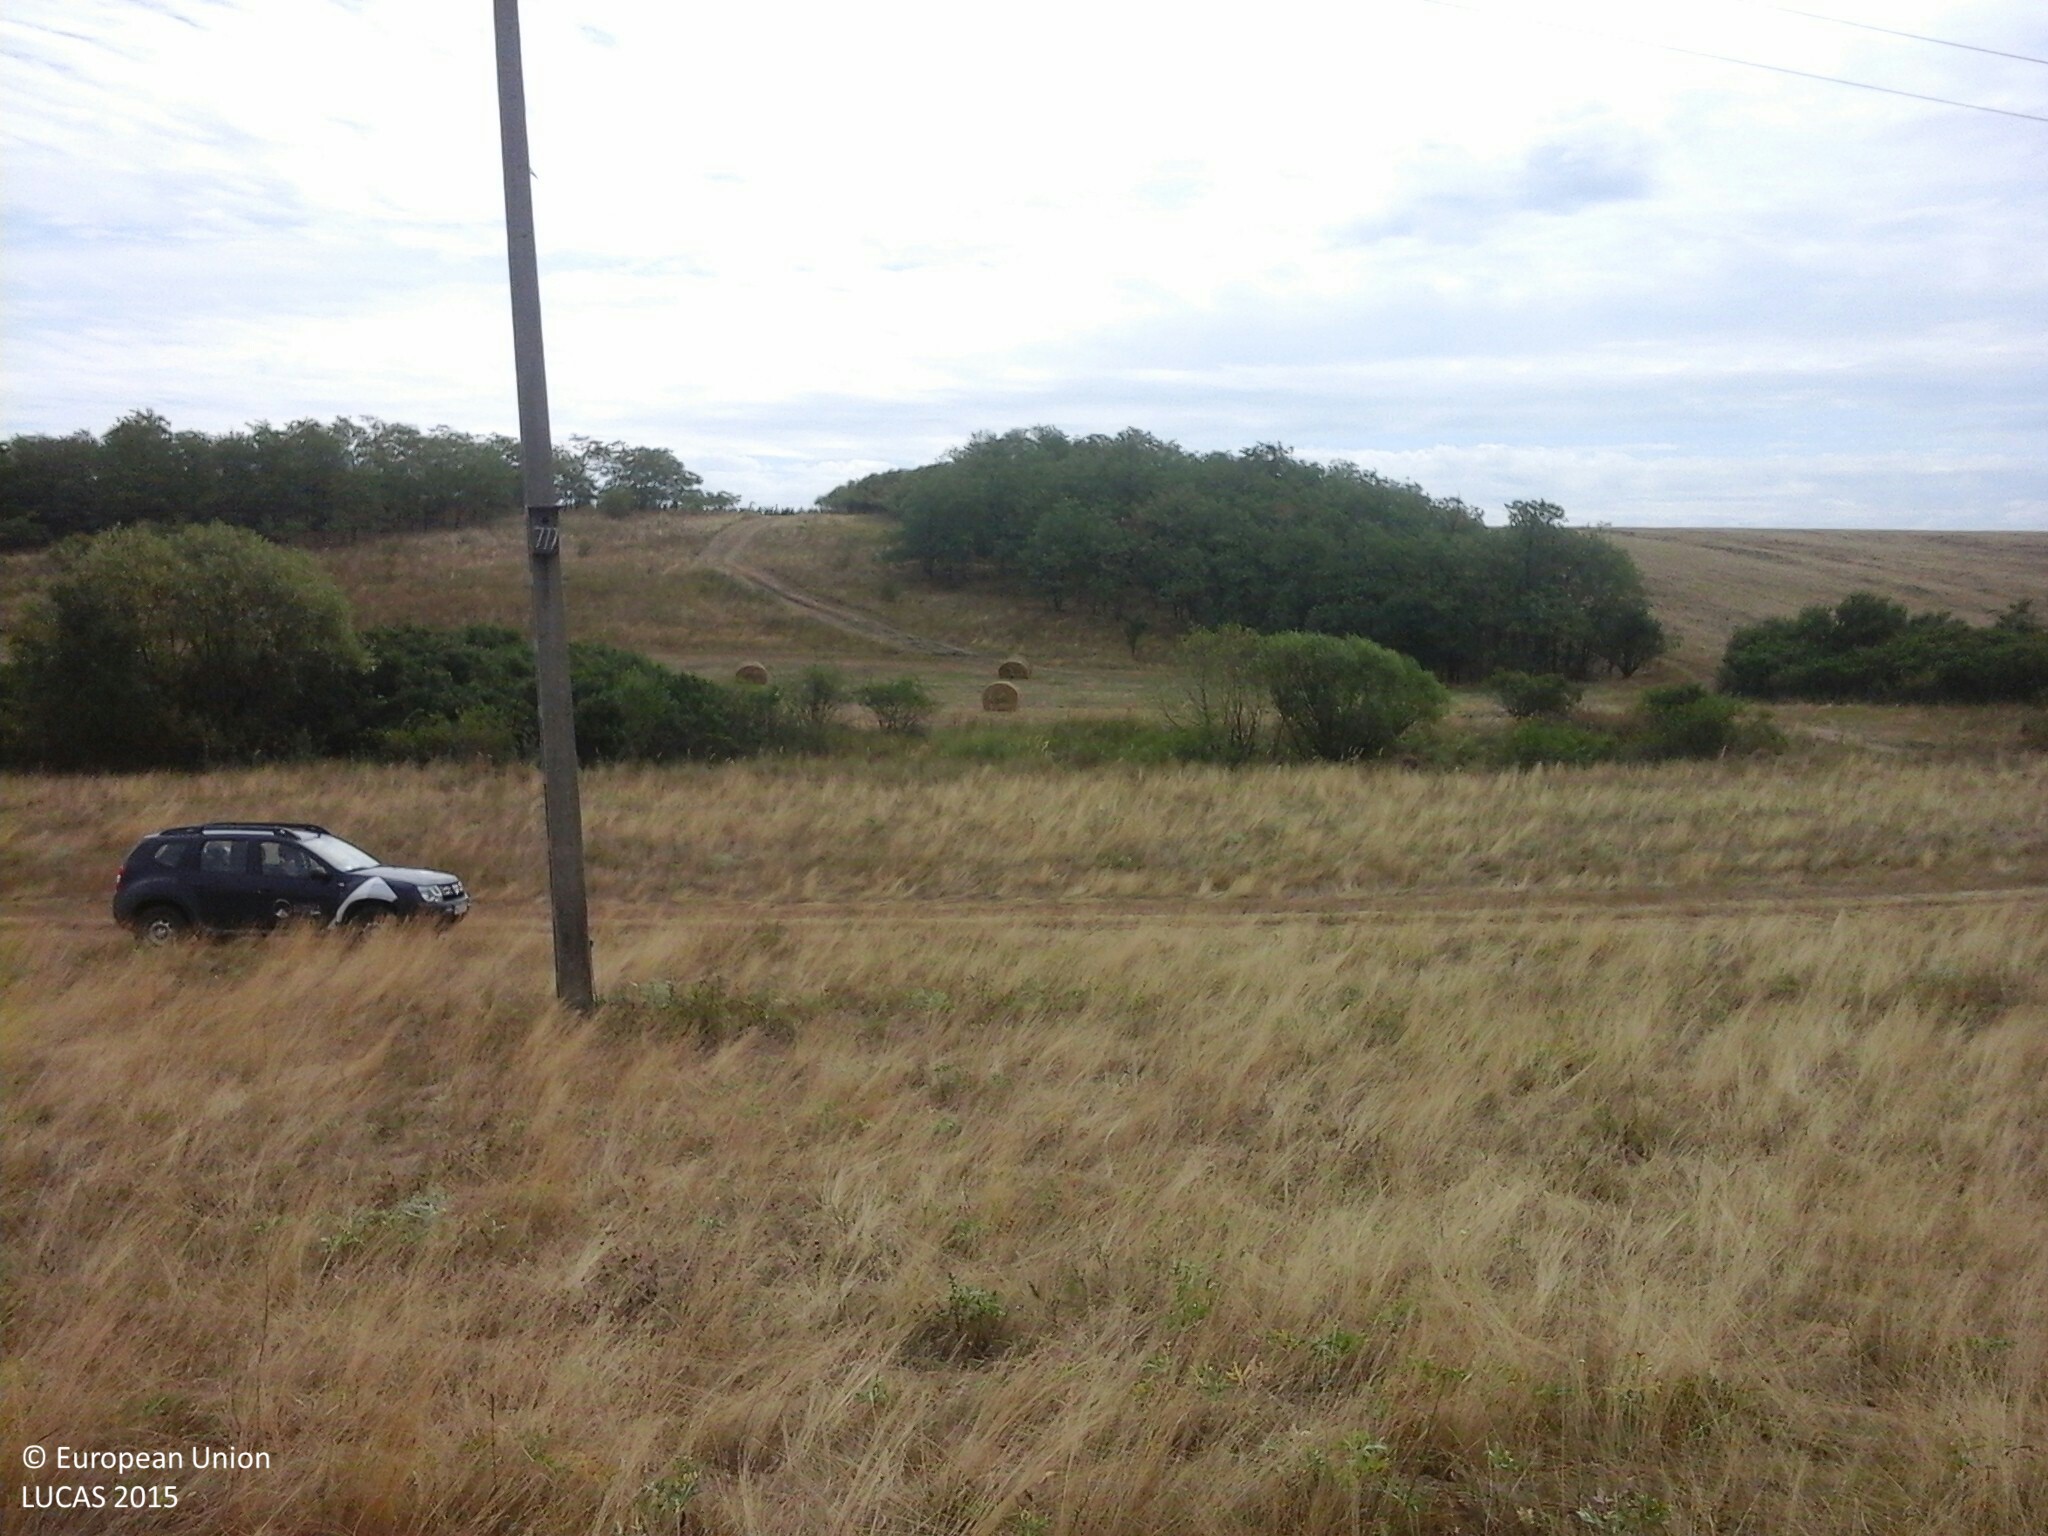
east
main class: Grassland
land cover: Grassland without tree/shrub cover
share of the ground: > 75 %
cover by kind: herbaceous plants 100 %
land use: Agriculture (excluding fallow land and kitchen gardens)
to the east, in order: Grassland without tree/shrub cover; Electric lines; Grassland without tree/shrub cover; Tracks; Grassland without tree/shrub cover; Shrubland with sparse tree cover; Ditches and canals; Shrubland with sparse tree cover; Grassland without tree/shrub cover; Broadleaved woodland; Tracks; Vineyards
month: July
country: HU
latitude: 47.8708
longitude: 20.6360
